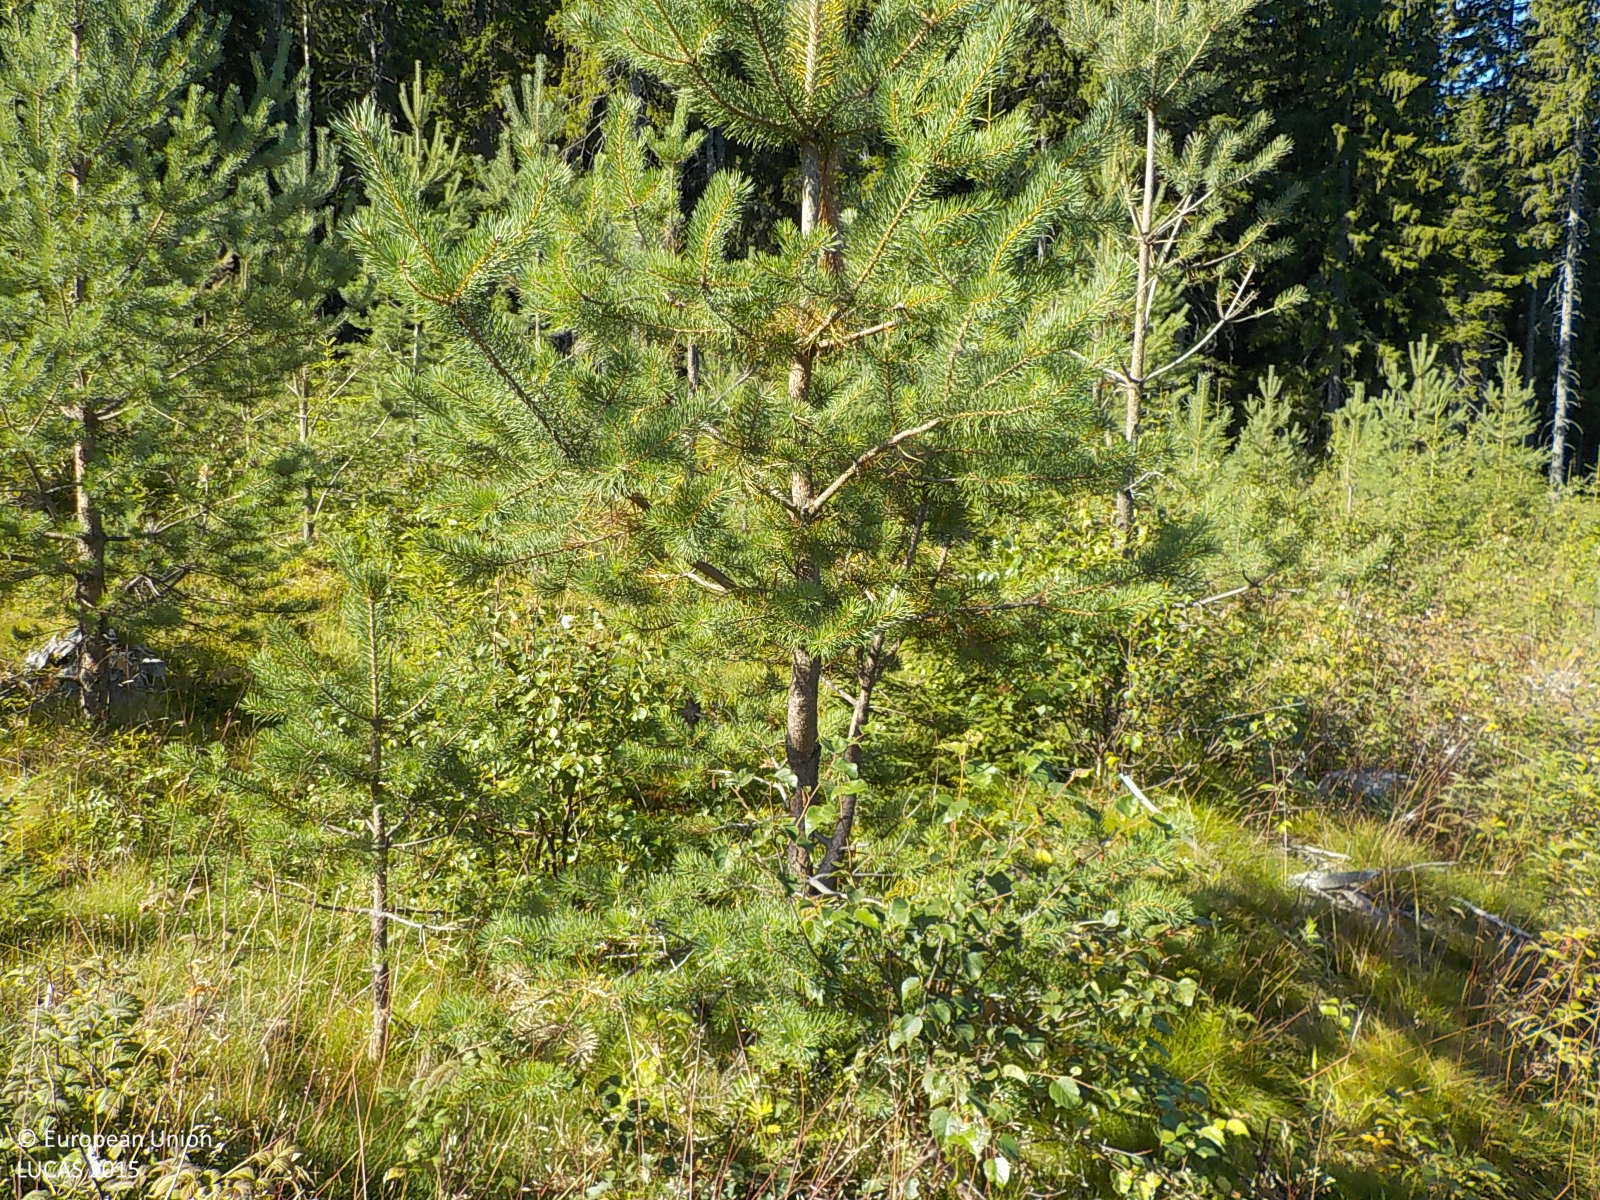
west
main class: Woodland
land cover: Pine dominated coniferous woodland
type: boreal forest
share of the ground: 50 - 75 %
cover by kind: coniferous forest trees 60 %, shrubs 40 %
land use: Forestry
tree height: < 5 m
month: August
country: SE
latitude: 63.4904
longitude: 18.6314
